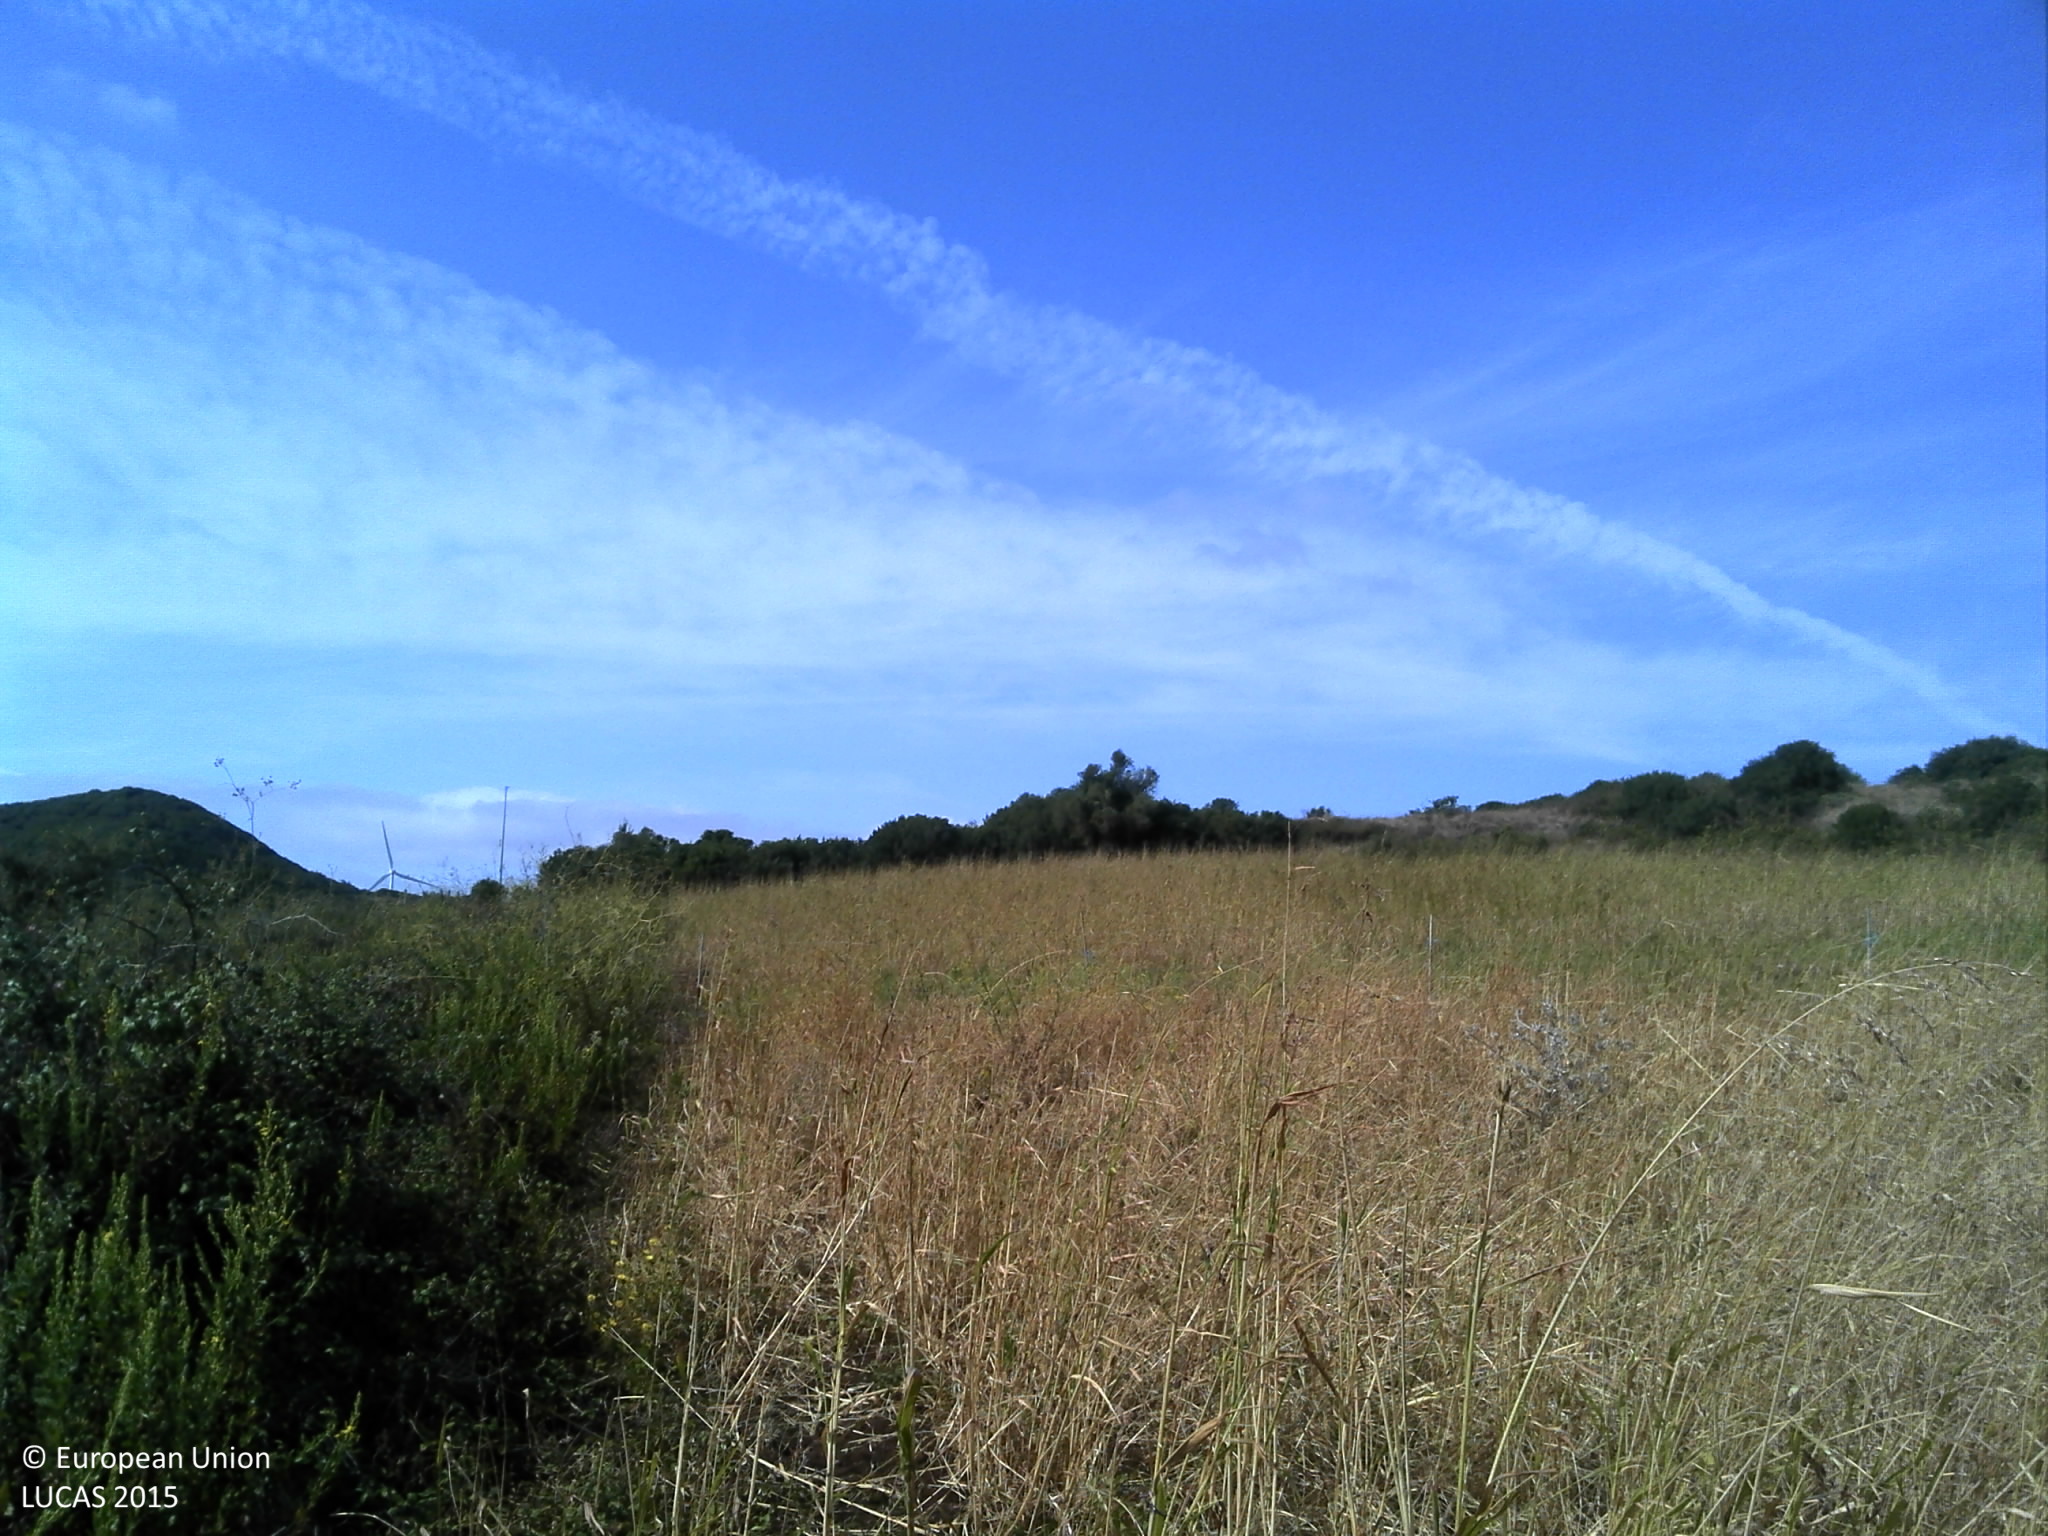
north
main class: Cropland
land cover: Other cereals
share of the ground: 50 - 75 %
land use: Agriculture (excluding fallow land and kitchen gardens)
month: September
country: PT
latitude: 38.8696
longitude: -9.2009
